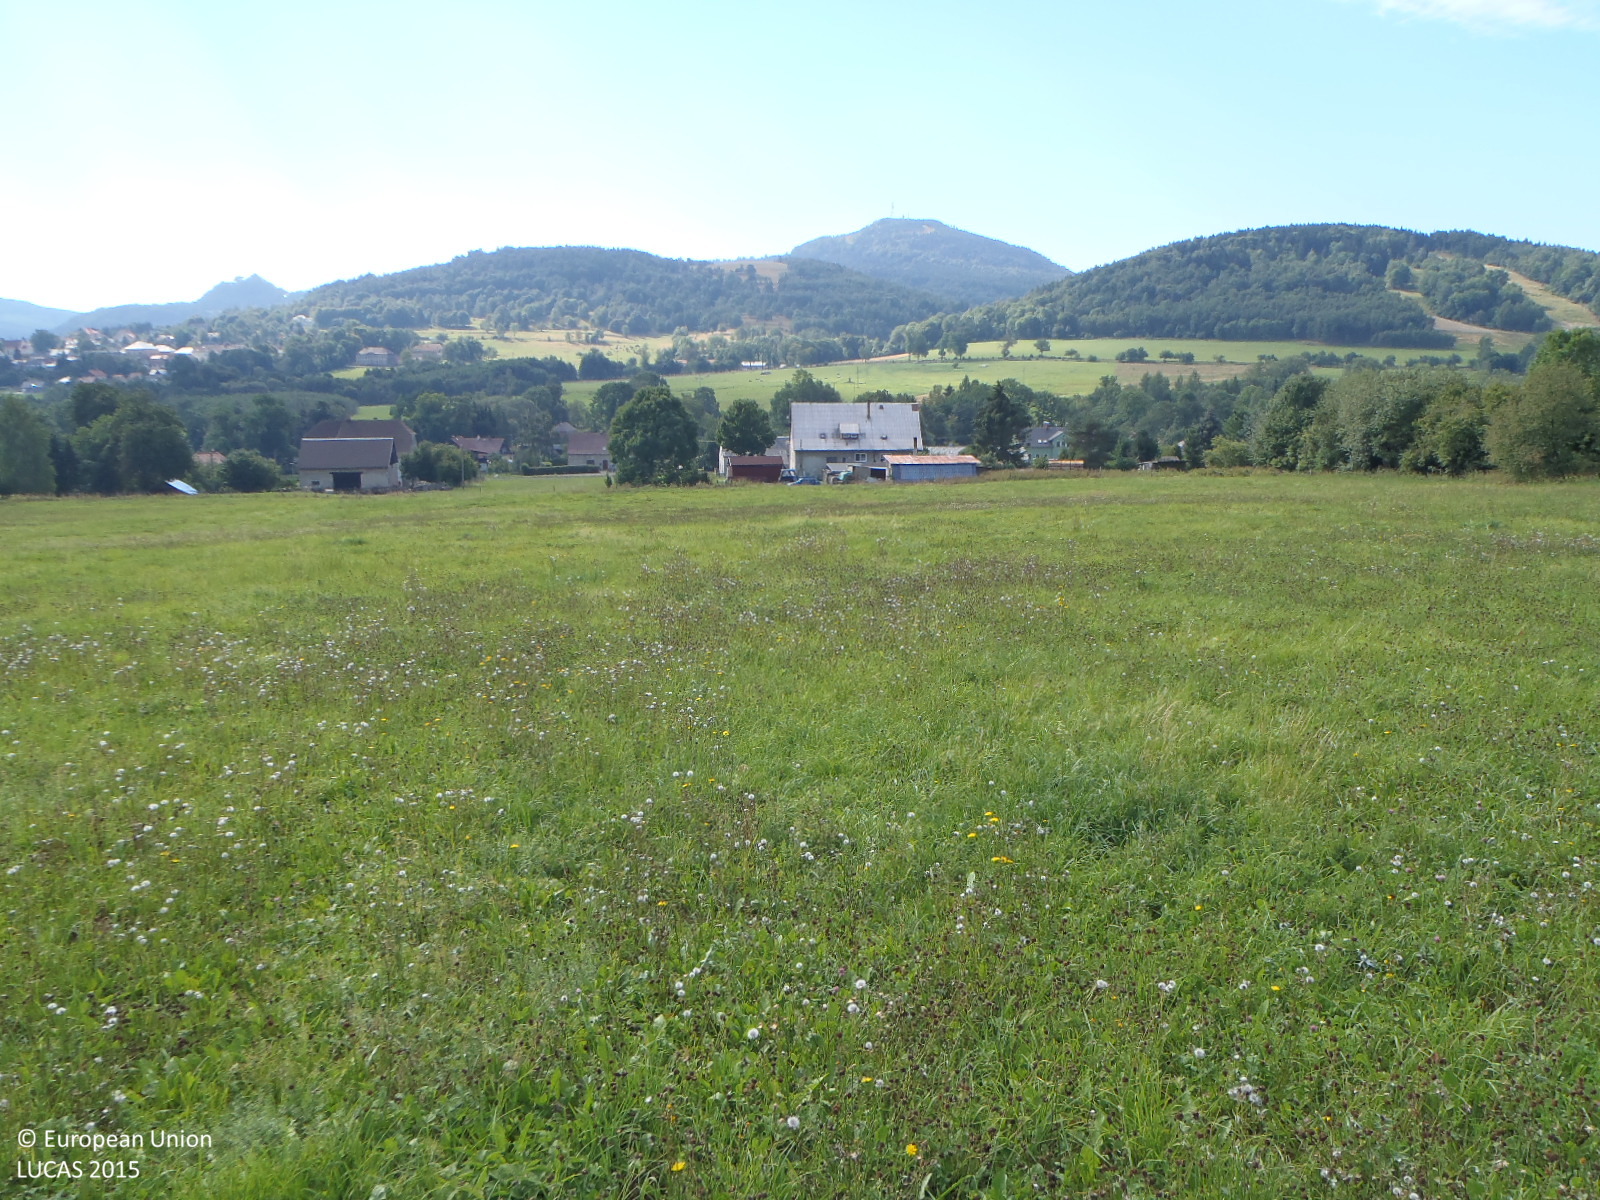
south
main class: Grassland
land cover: Grassland without tree/shrub cover
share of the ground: > 75 %
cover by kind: herbaceous plants 100 %
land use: Agriculture (excluding fallow land and kitchen gardens)
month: August
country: CZ
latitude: 50.8853
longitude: 14.5649
